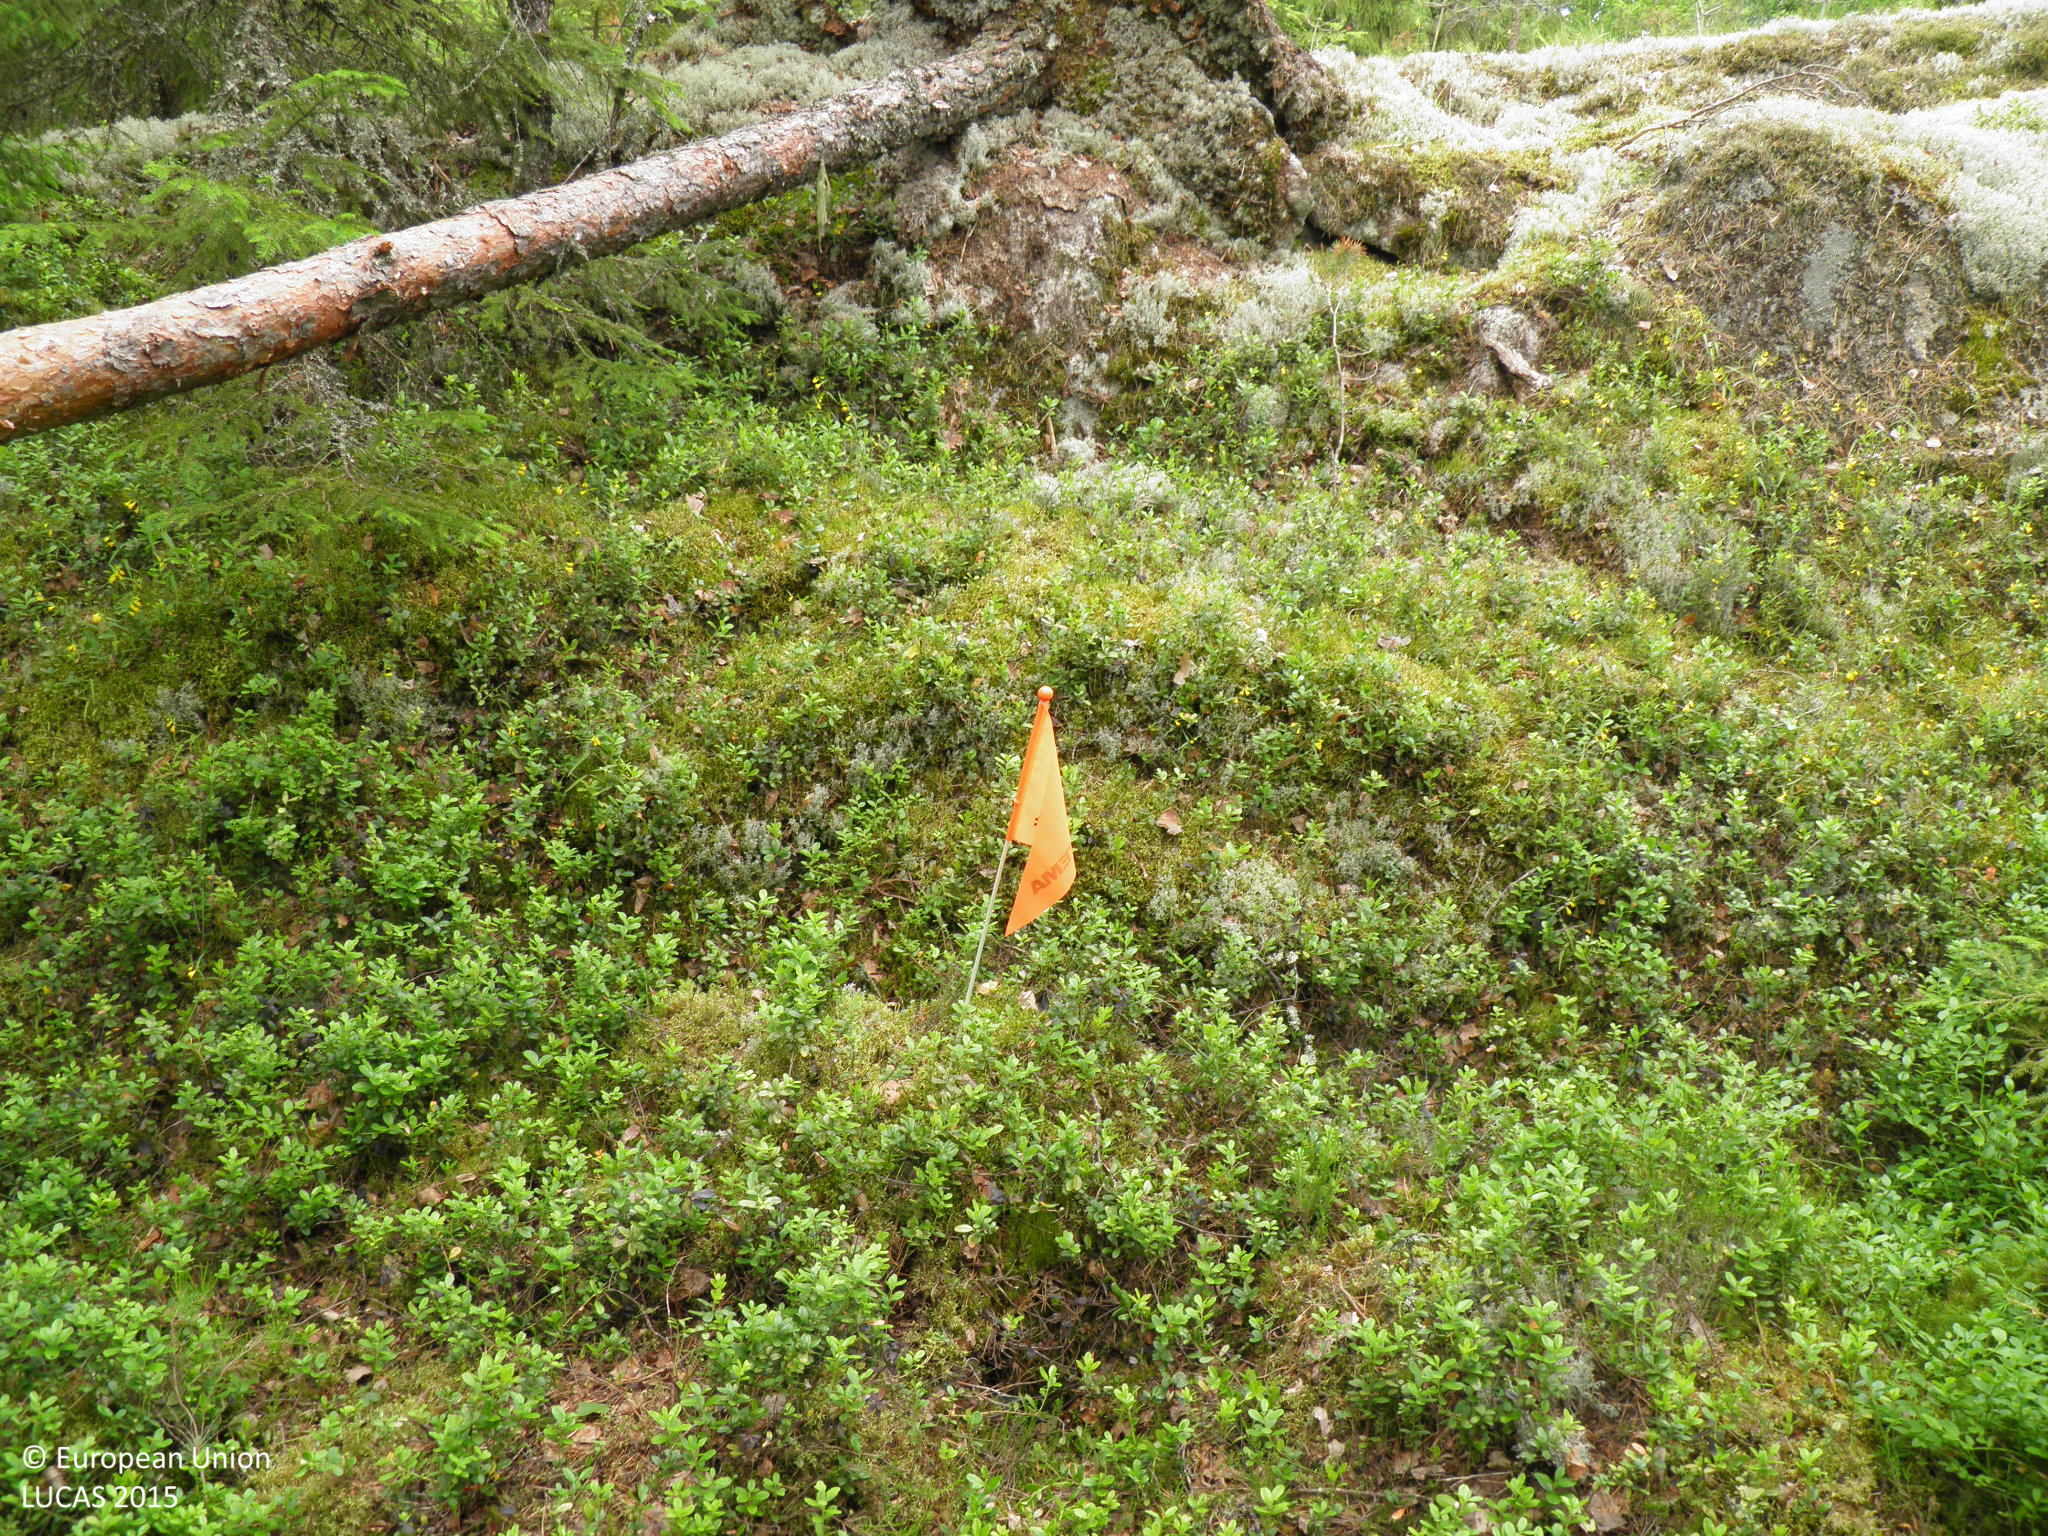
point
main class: Woodland
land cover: Pine dominated coniferous woodland
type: hemiboreal forest and nemoral coniferous forest and mixed broadleaved-coniferous forest
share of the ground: 50 - 75 %
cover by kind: coniferous forest trees 50 %, shrubs 25 %, broadleaved forest trees 15 %, lichens and mosses 10 %
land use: Forestry
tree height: > 5 m
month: July
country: FI
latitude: 60.8883
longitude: 22.4307
